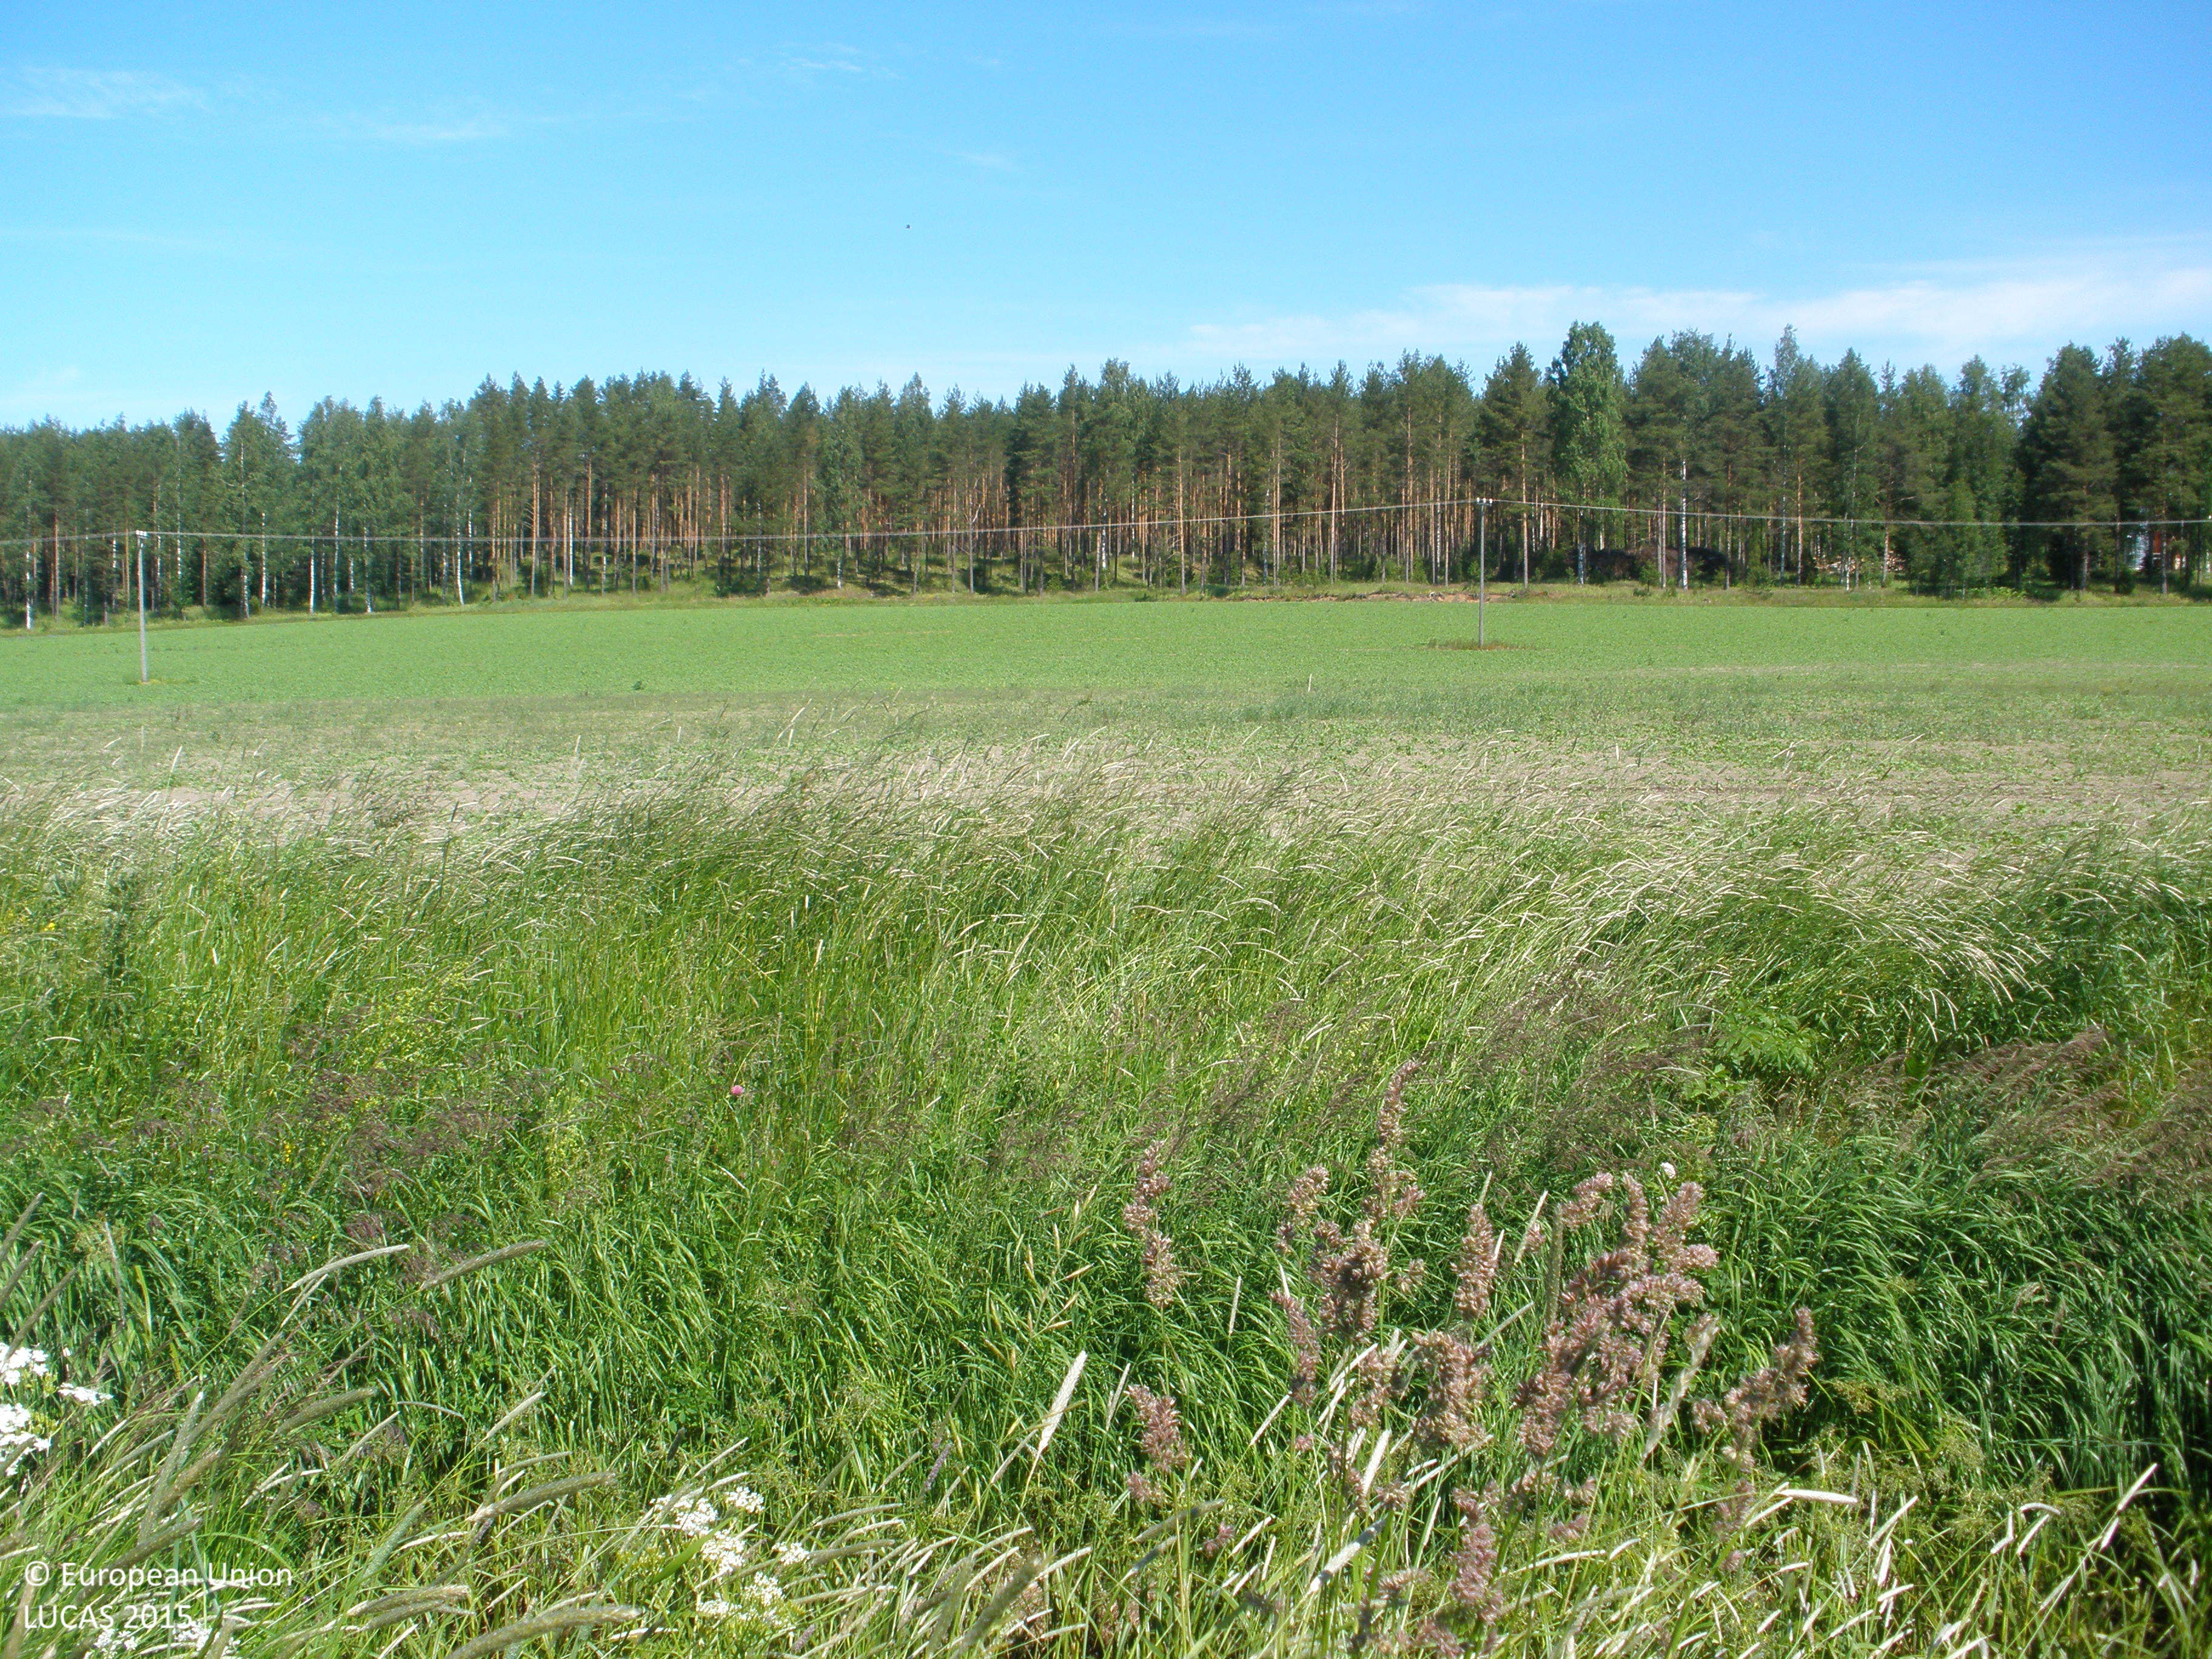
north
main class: Cropland
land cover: Other root crops
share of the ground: 10 - 25 %
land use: Agriculture (excluding fallow land and kitchen gardens)
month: July
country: FI
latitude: 61.0470
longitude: 23.6973
